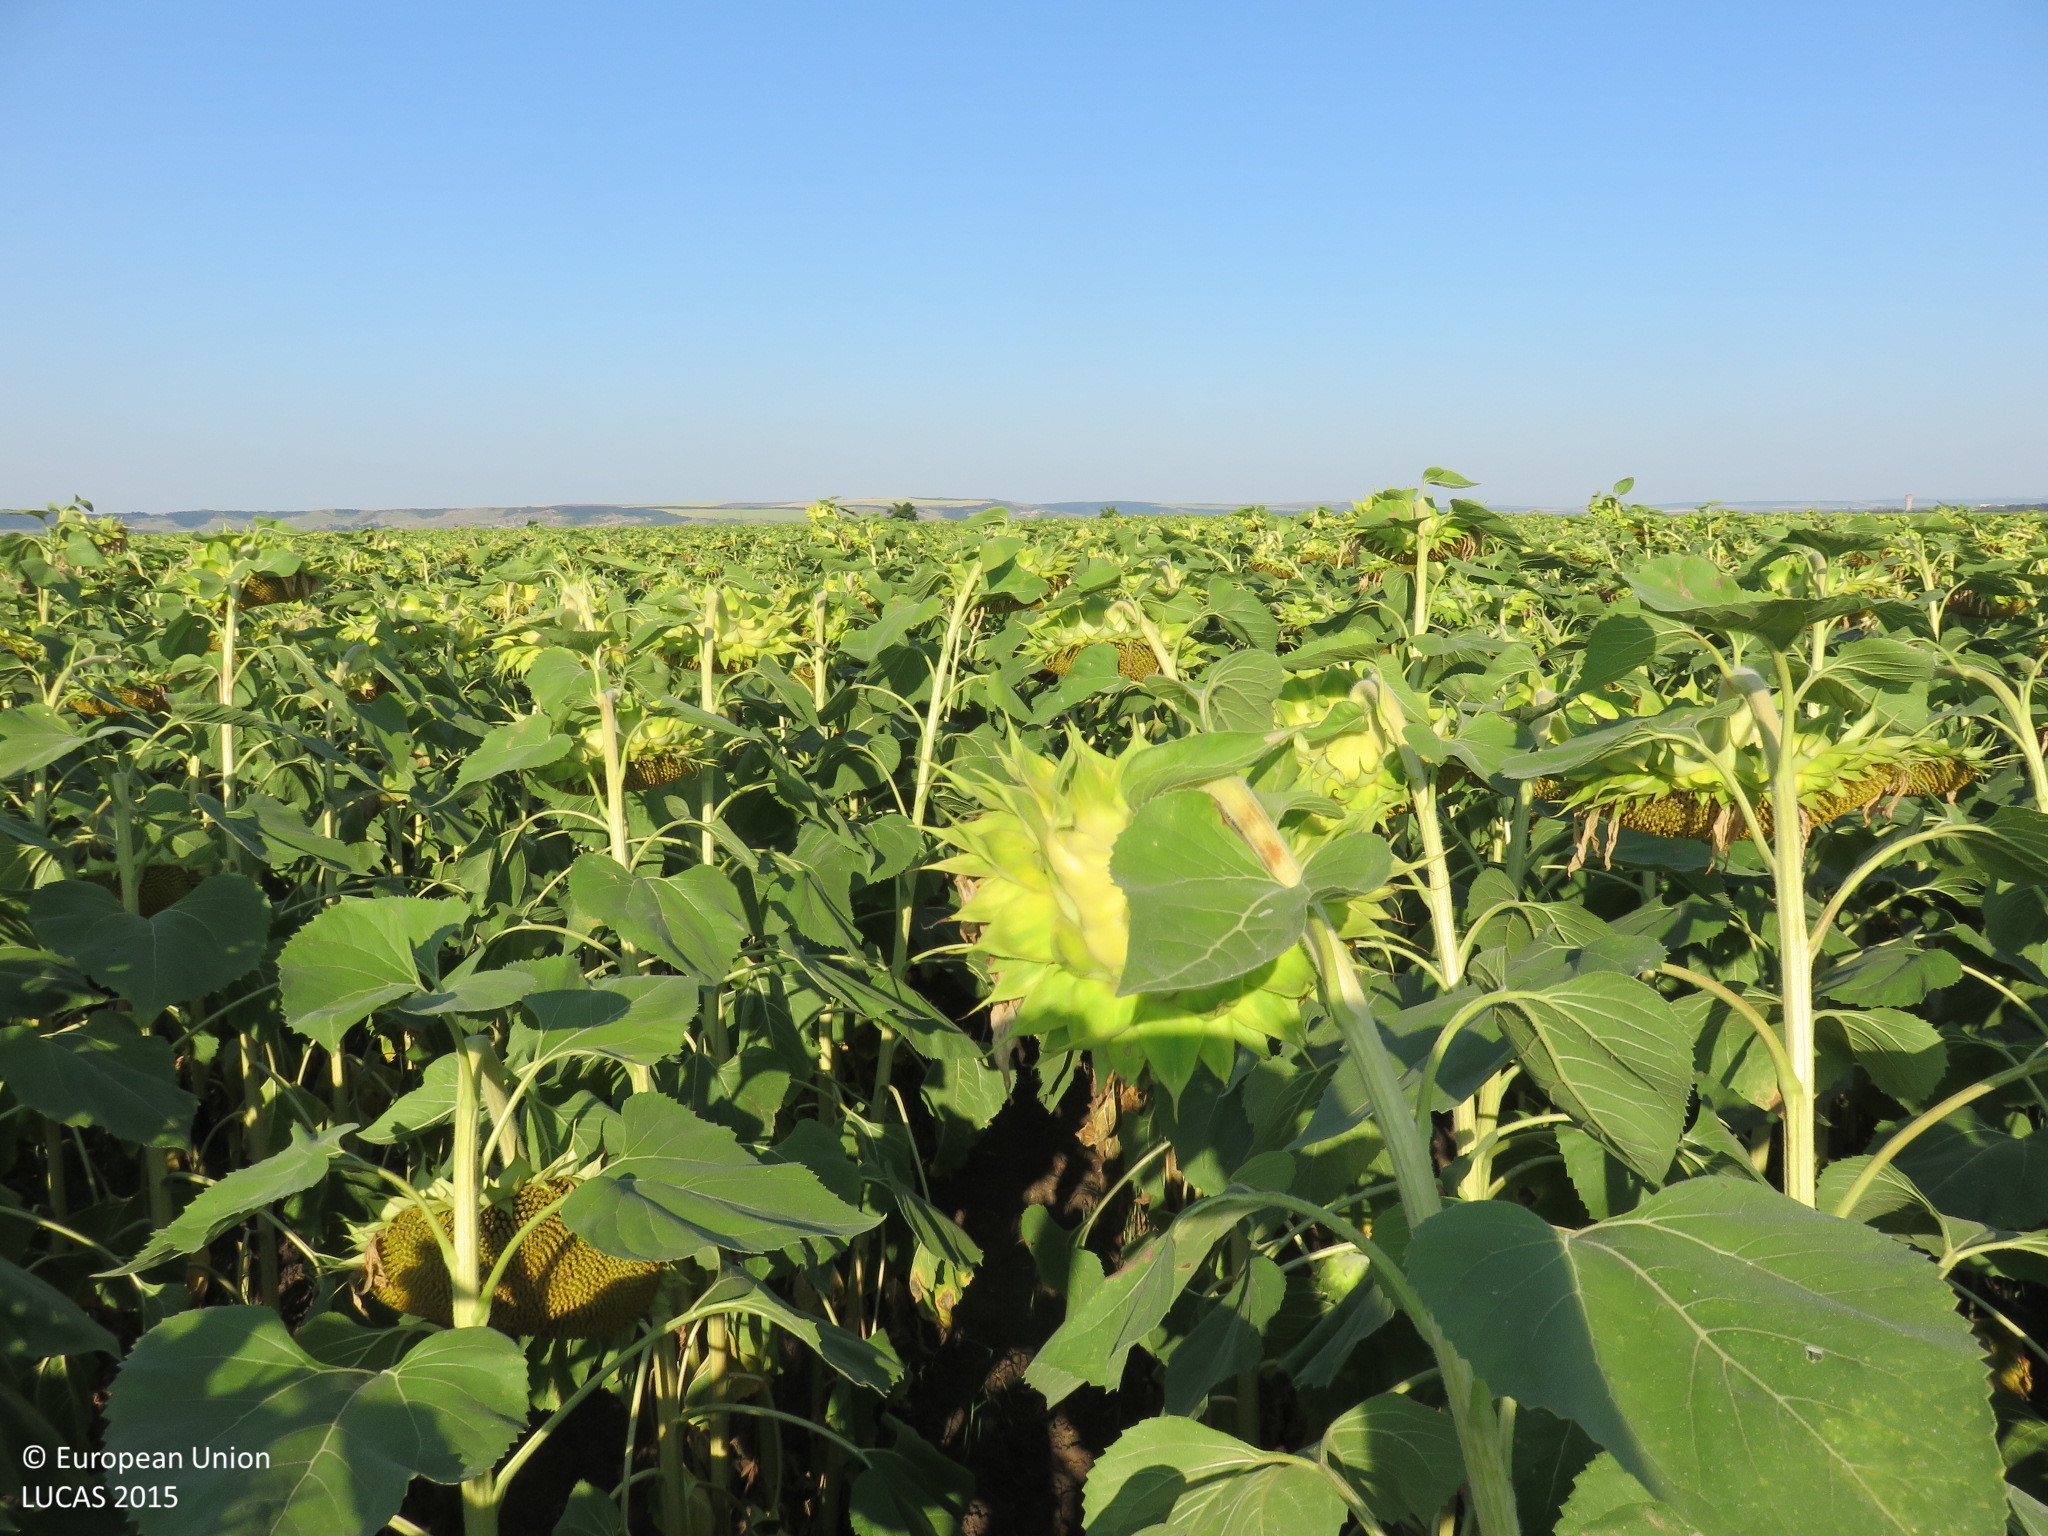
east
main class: Cropland
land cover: Sunflower
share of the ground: > 75 %
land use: Agriculture (excluding fallow land and kitchen gardens)
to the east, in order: Sunflower
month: July
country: BG
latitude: 43.3854
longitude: 25.0947
